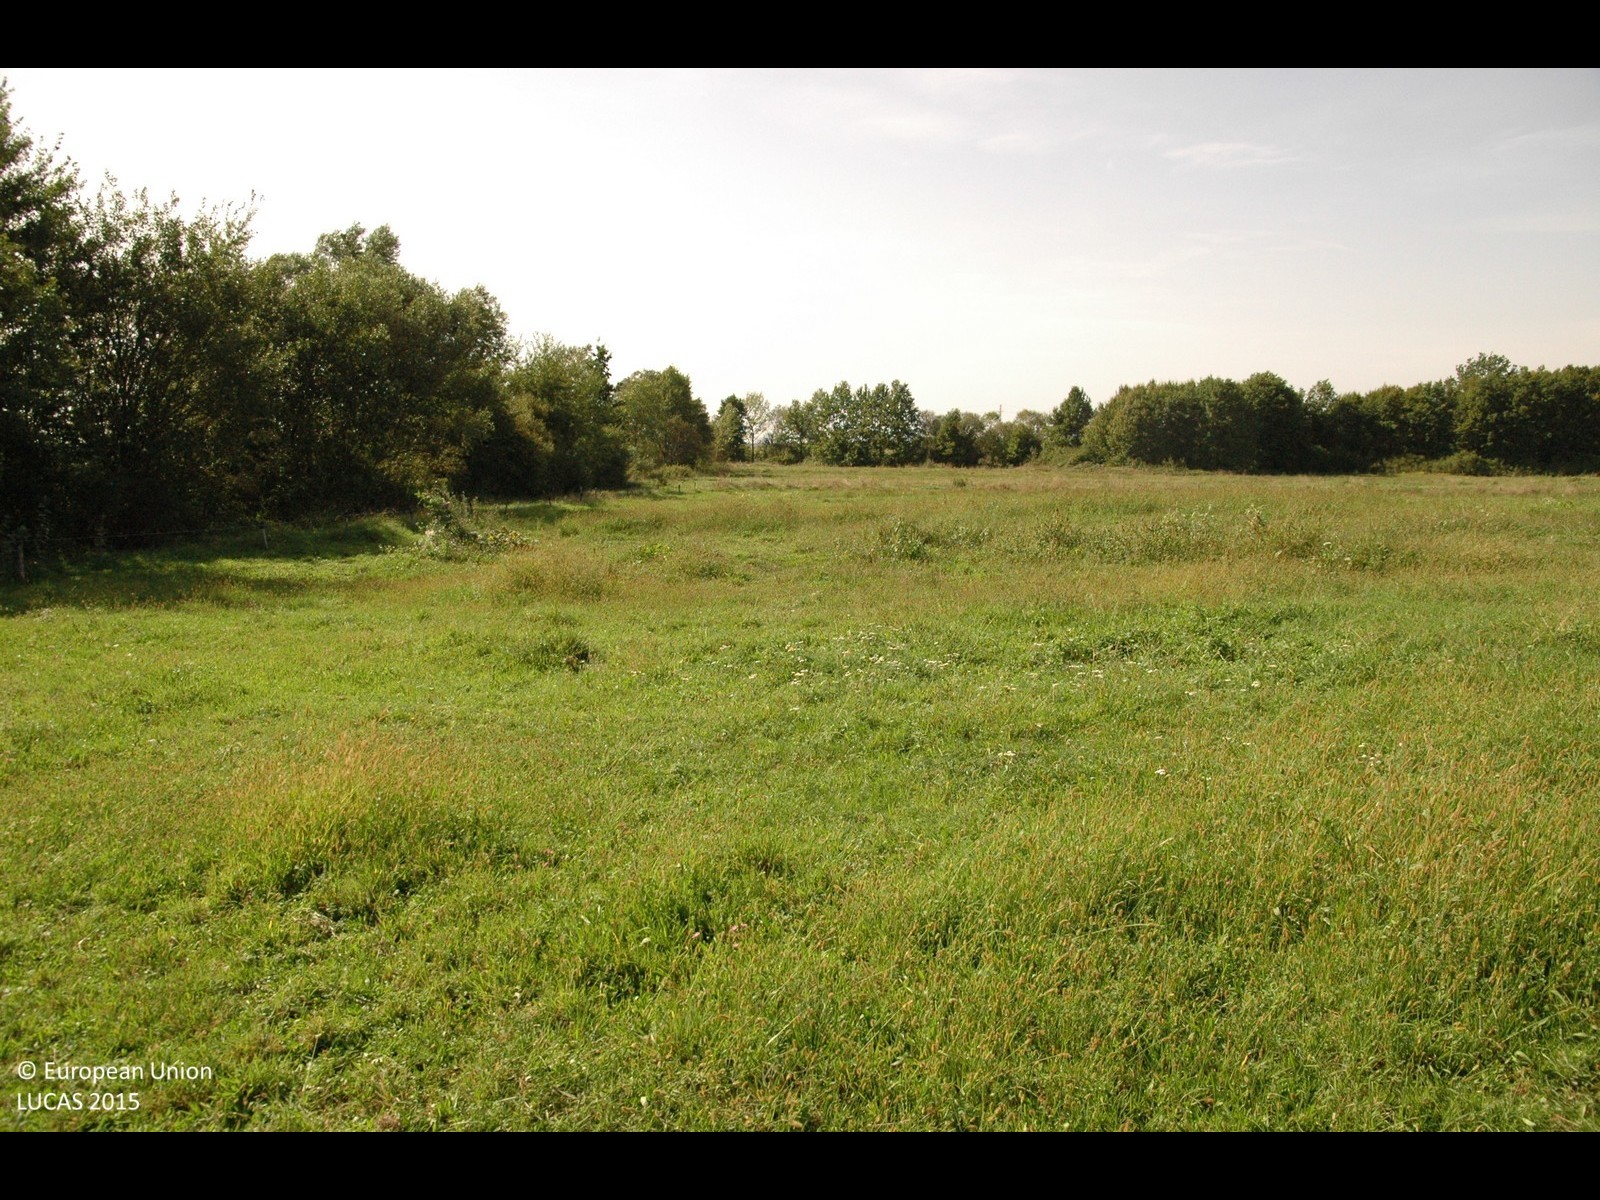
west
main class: Grassland
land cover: Grassland without tree/shrub cover
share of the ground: > 75 %
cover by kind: herbaceous plants 100 %
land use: Agriculture (excluding fallow land and kitchen gardens)
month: September
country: HR
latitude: 45.6142
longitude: 15.8318
